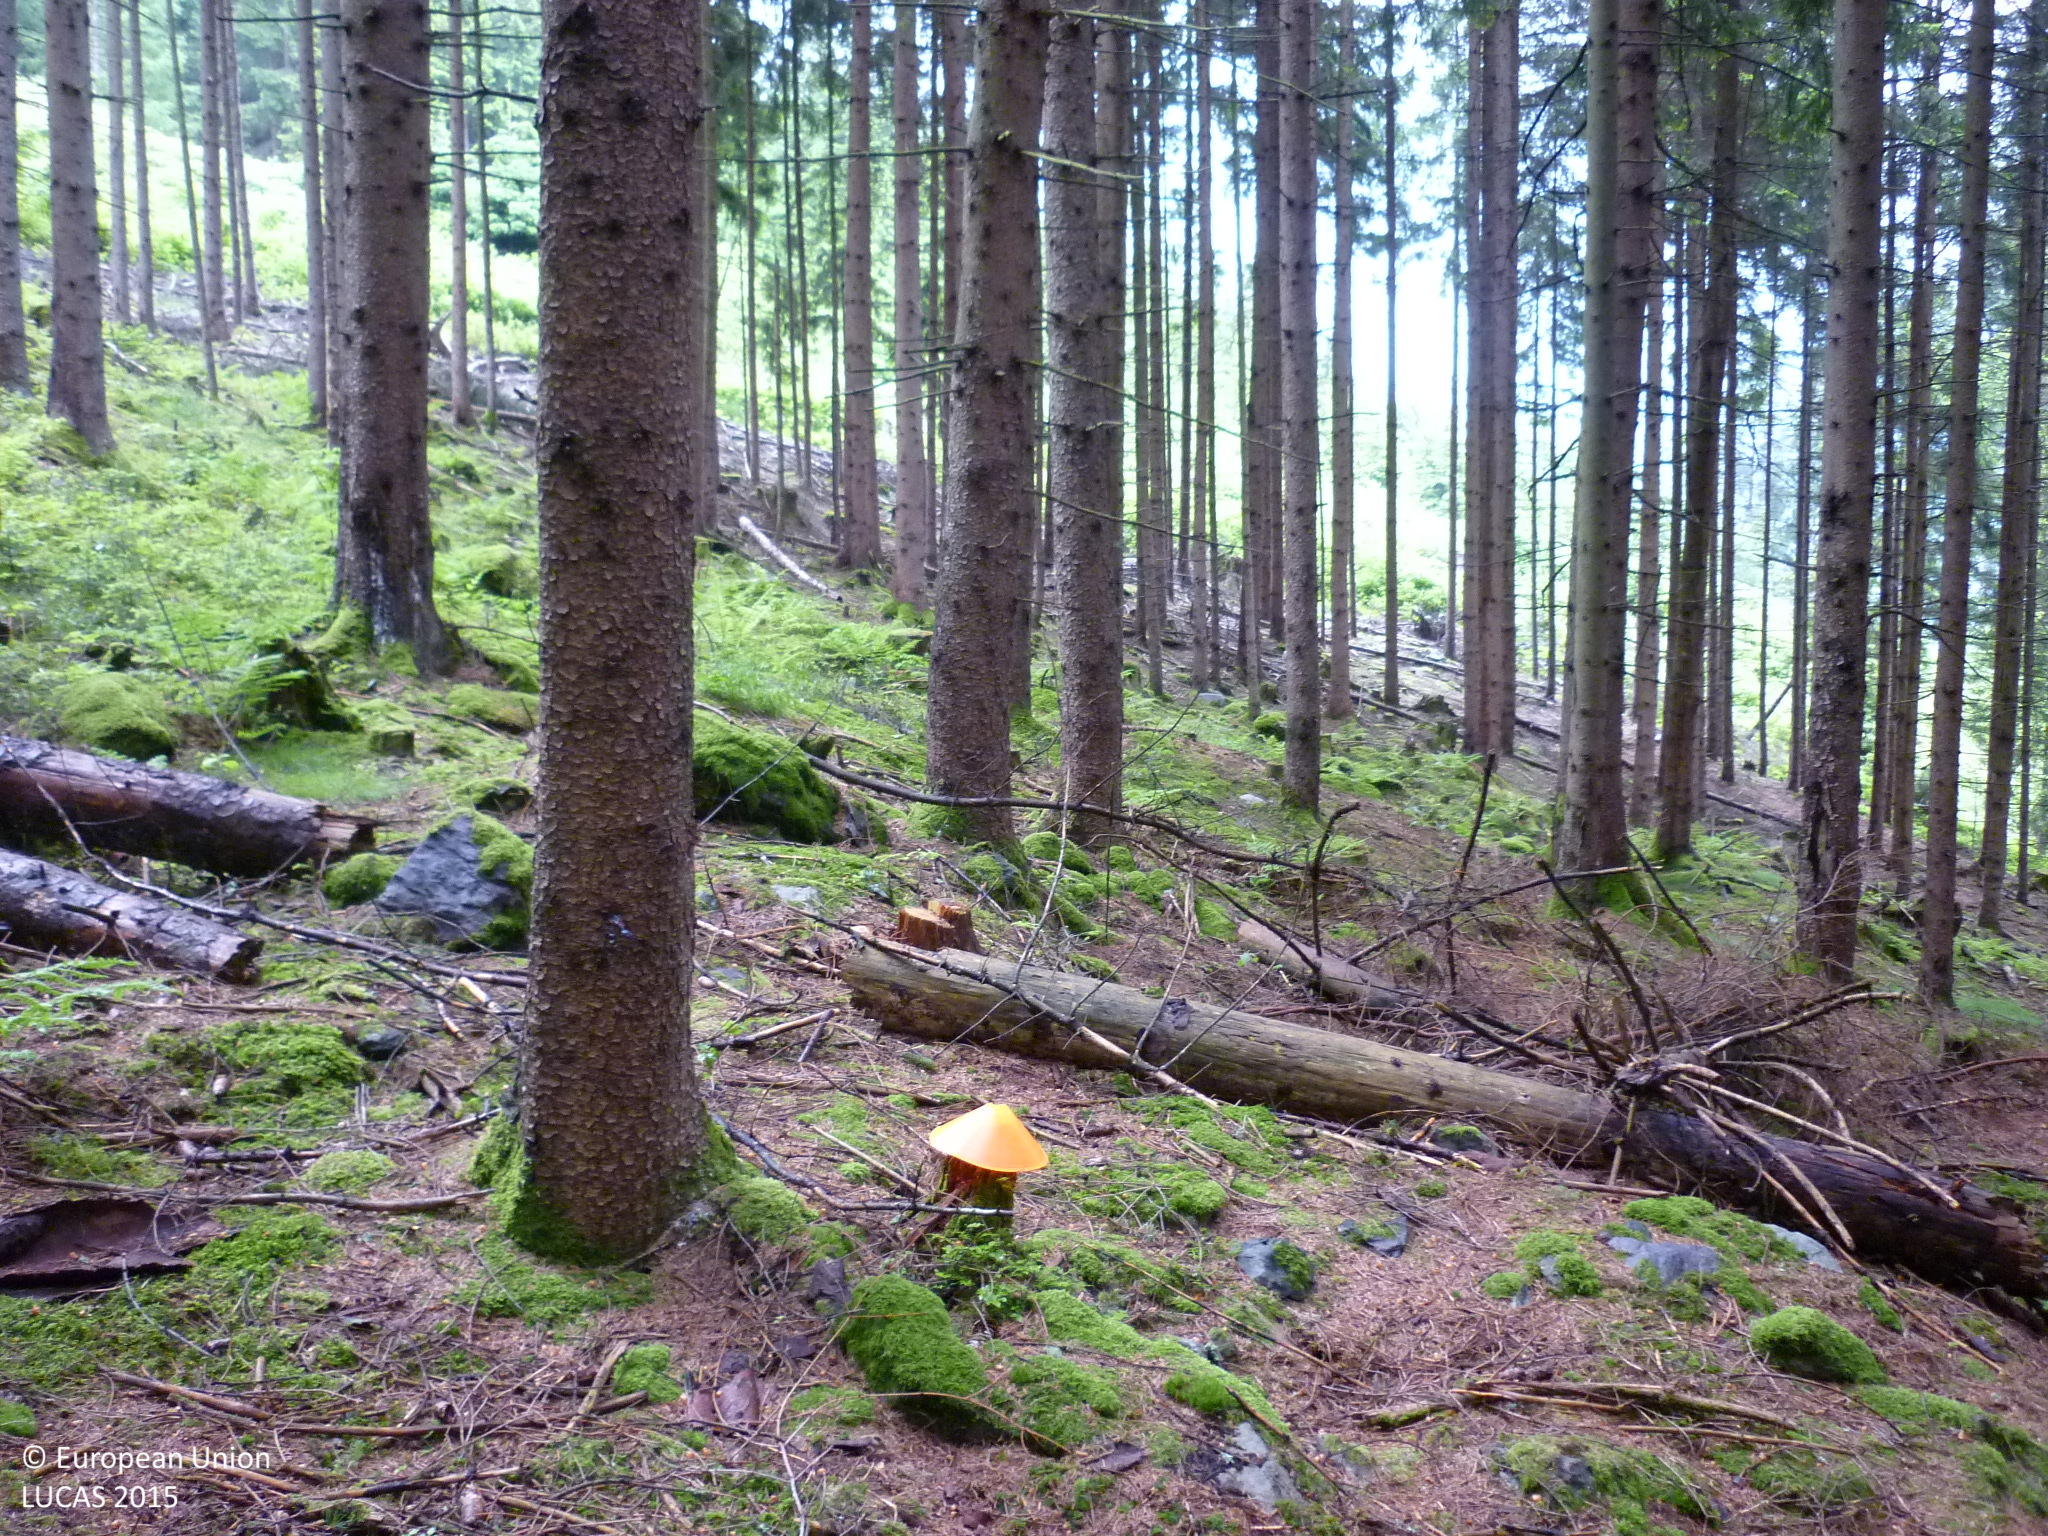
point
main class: Woodland
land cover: Spruce dominated coniferous woodland
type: alpine coniferous forest
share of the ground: > 75 %
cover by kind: coniferous forest trees 90 %, lichens and mosses 10 %
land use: Forestry
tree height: > 5 m
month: May
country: AT
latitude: 47.5961
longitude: 14.3747
